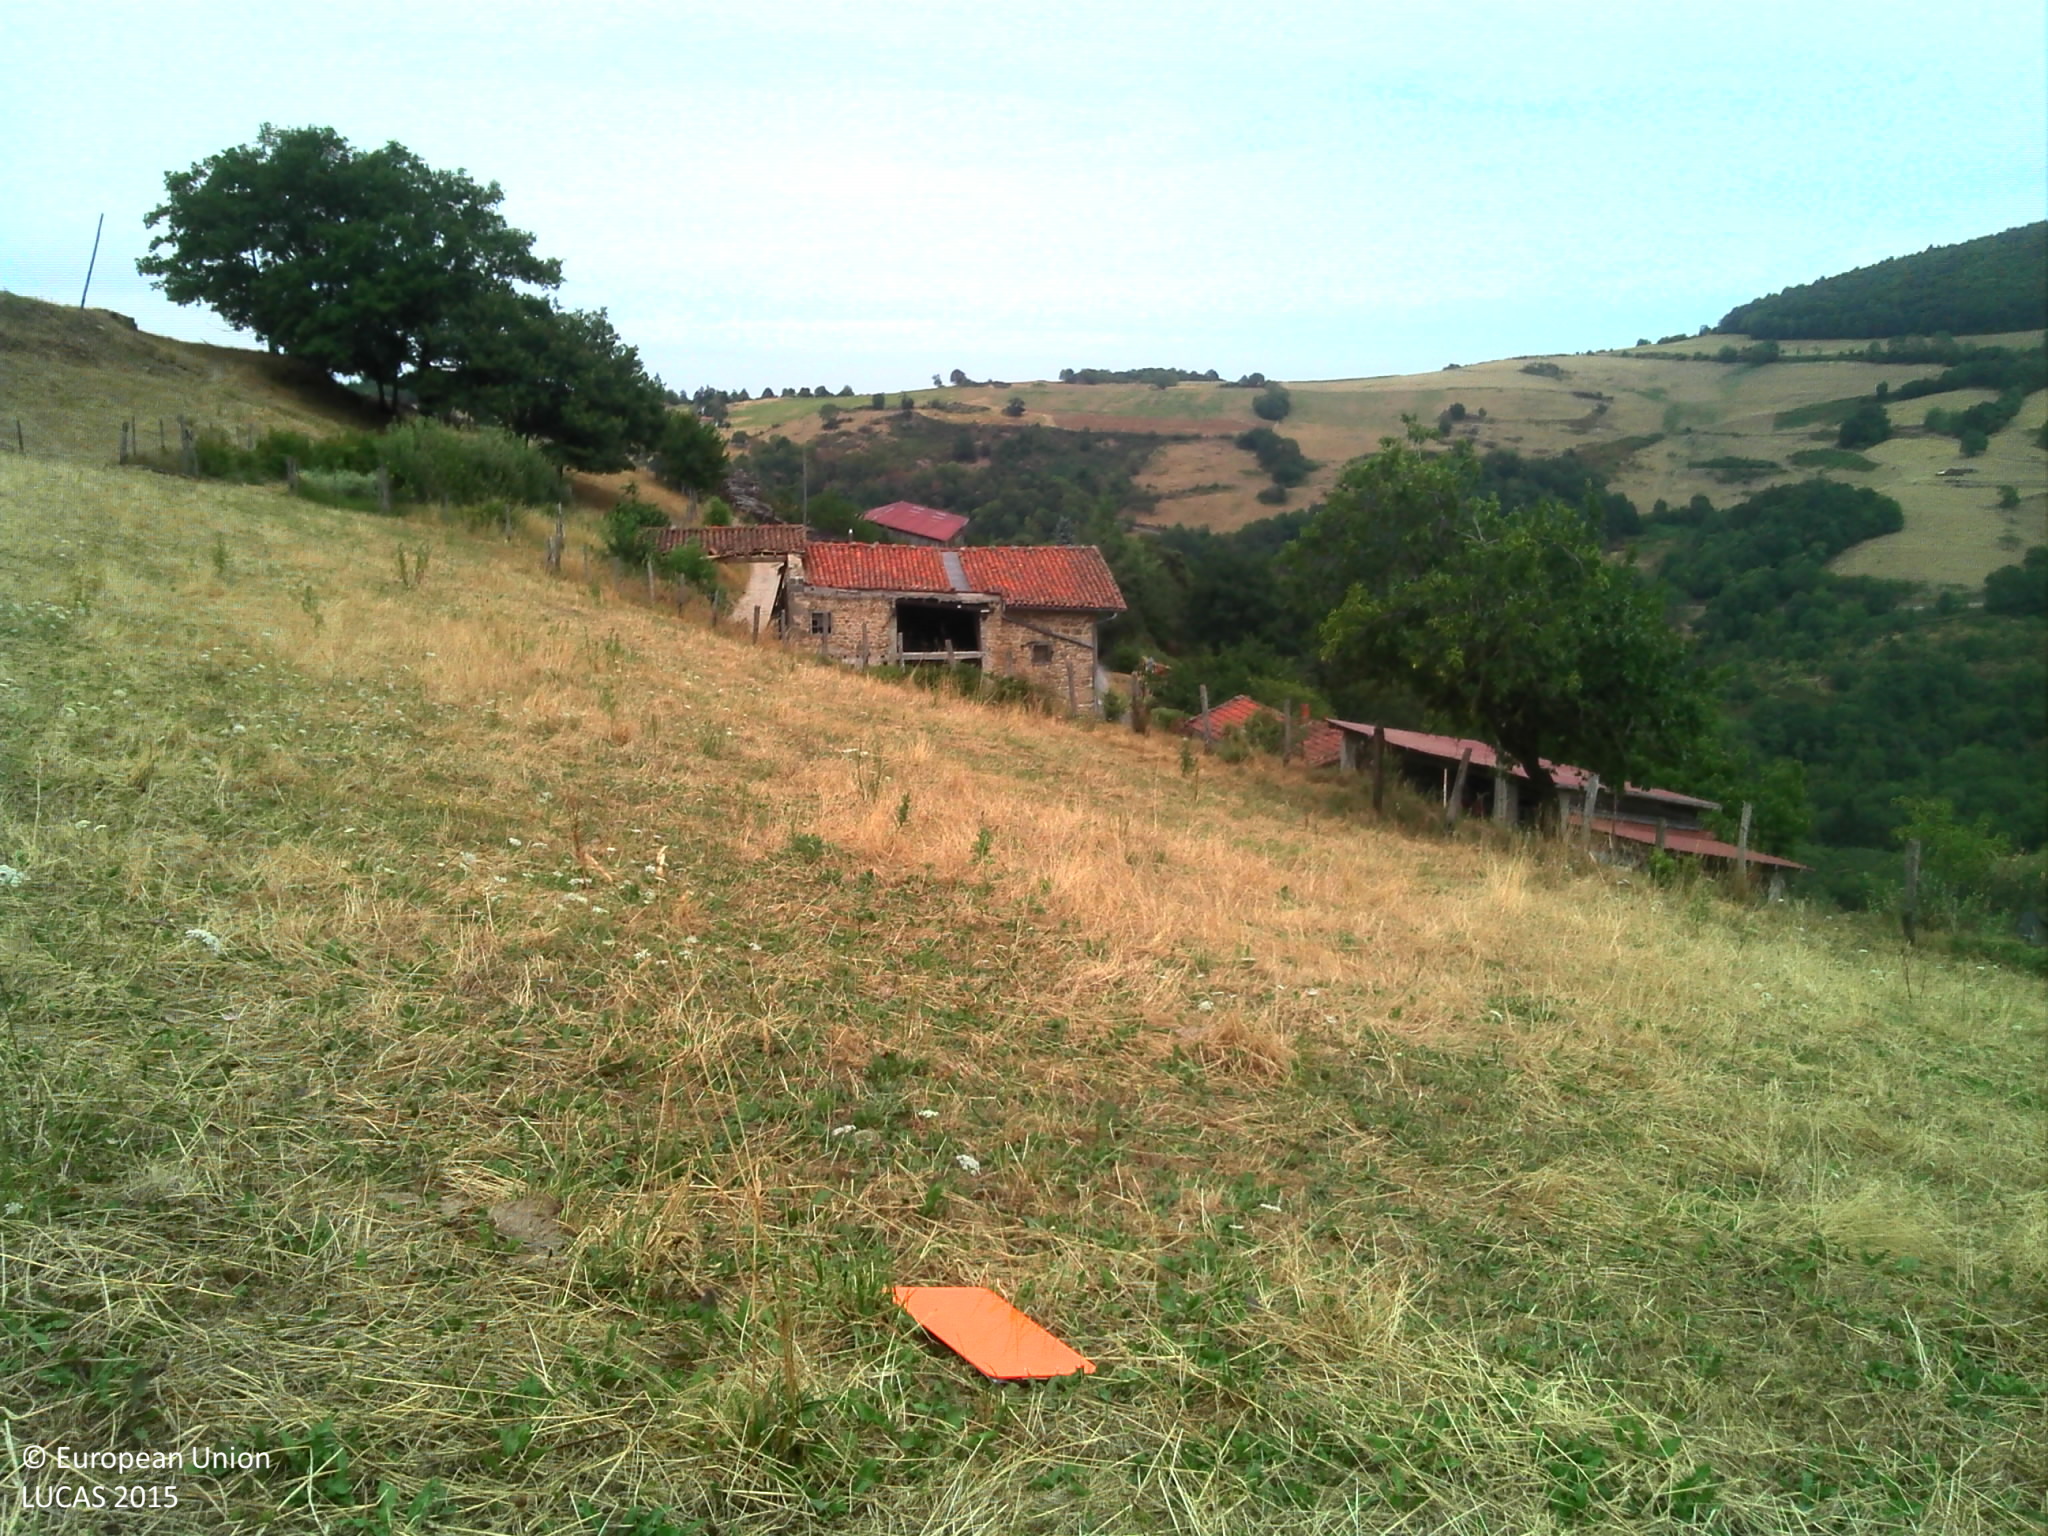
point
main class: Grassland
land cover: Grassland without tree/shrub cover
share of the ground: > 75 %
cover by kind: herbaceous plants 100 %
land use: Agriculture (excluding fallow land and kitchen gardens)
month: July
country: FR
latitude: 45.6859
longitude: 4.4950
